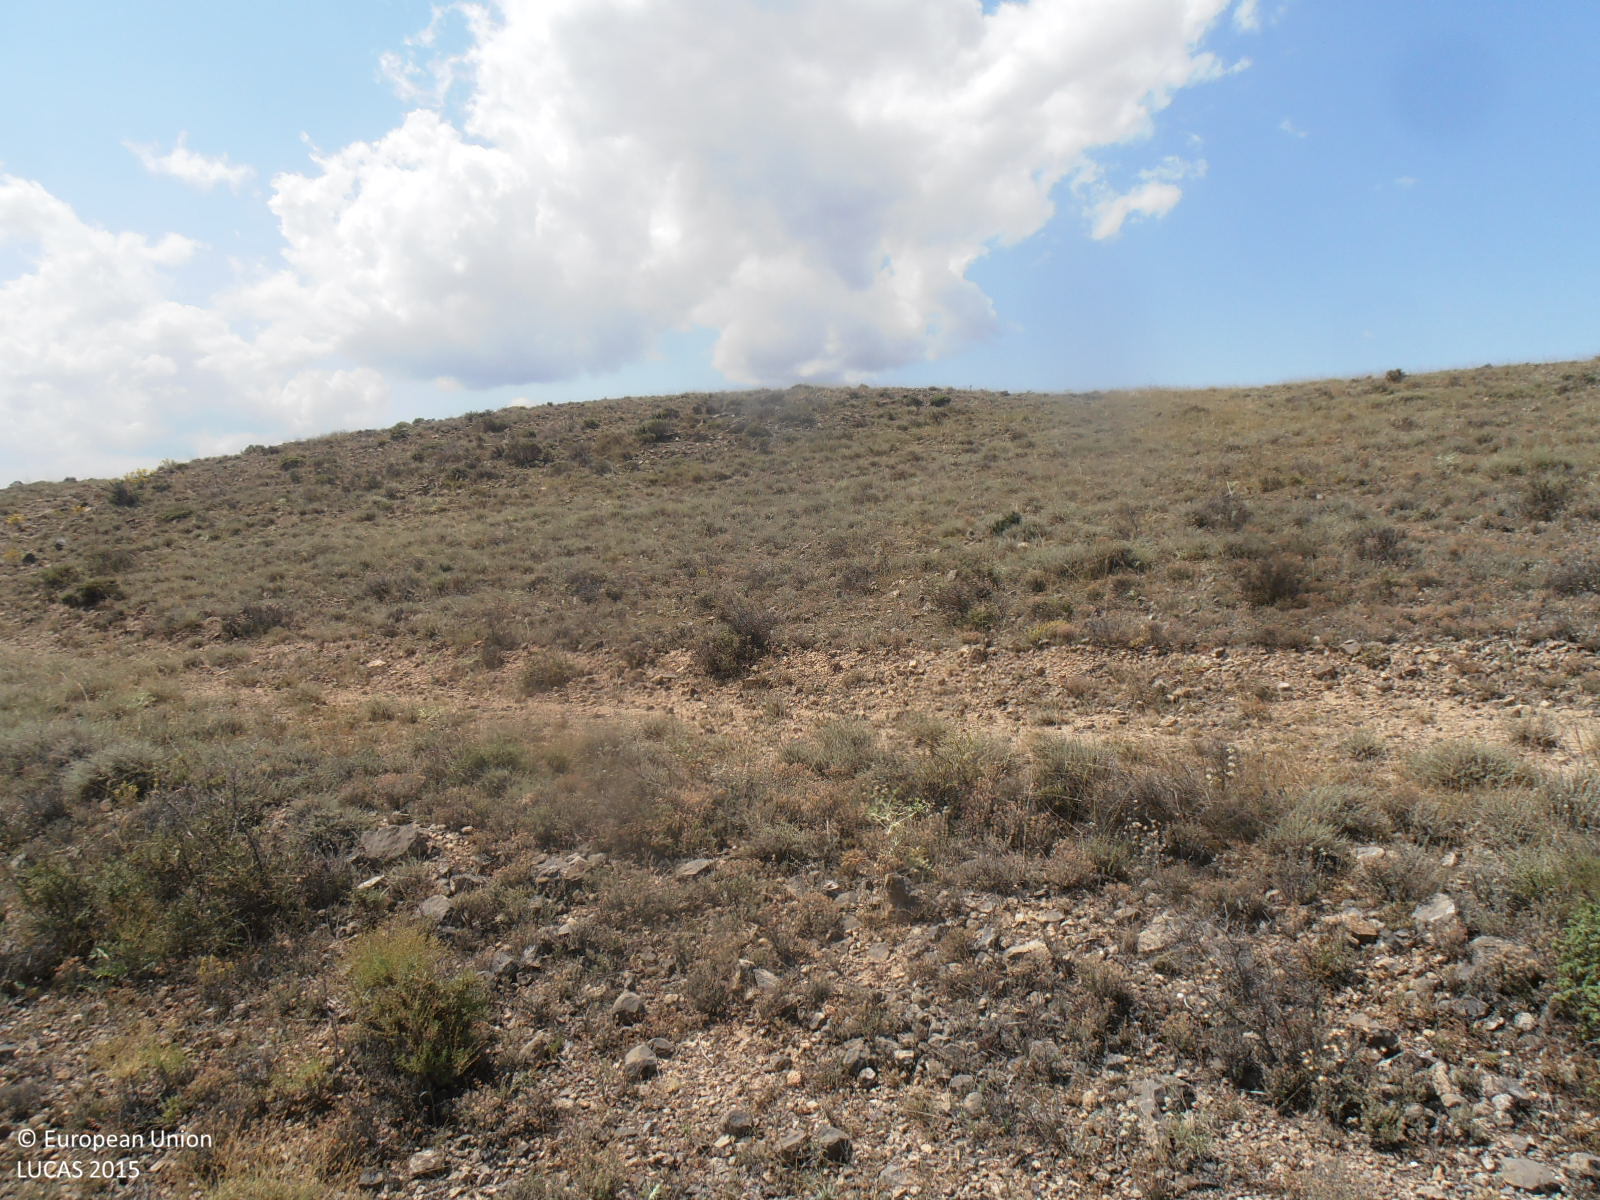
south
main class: Shrubland
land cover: Shrubland without tree cover
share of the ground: 25 - 50 %
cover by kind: consolidated bare surface 55 %, shrubs 40 %, herbaceous plants 5 %
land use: Semi-natural and natural areas not in use
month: June
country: ES
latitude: 41.5138
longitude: -1.4198
